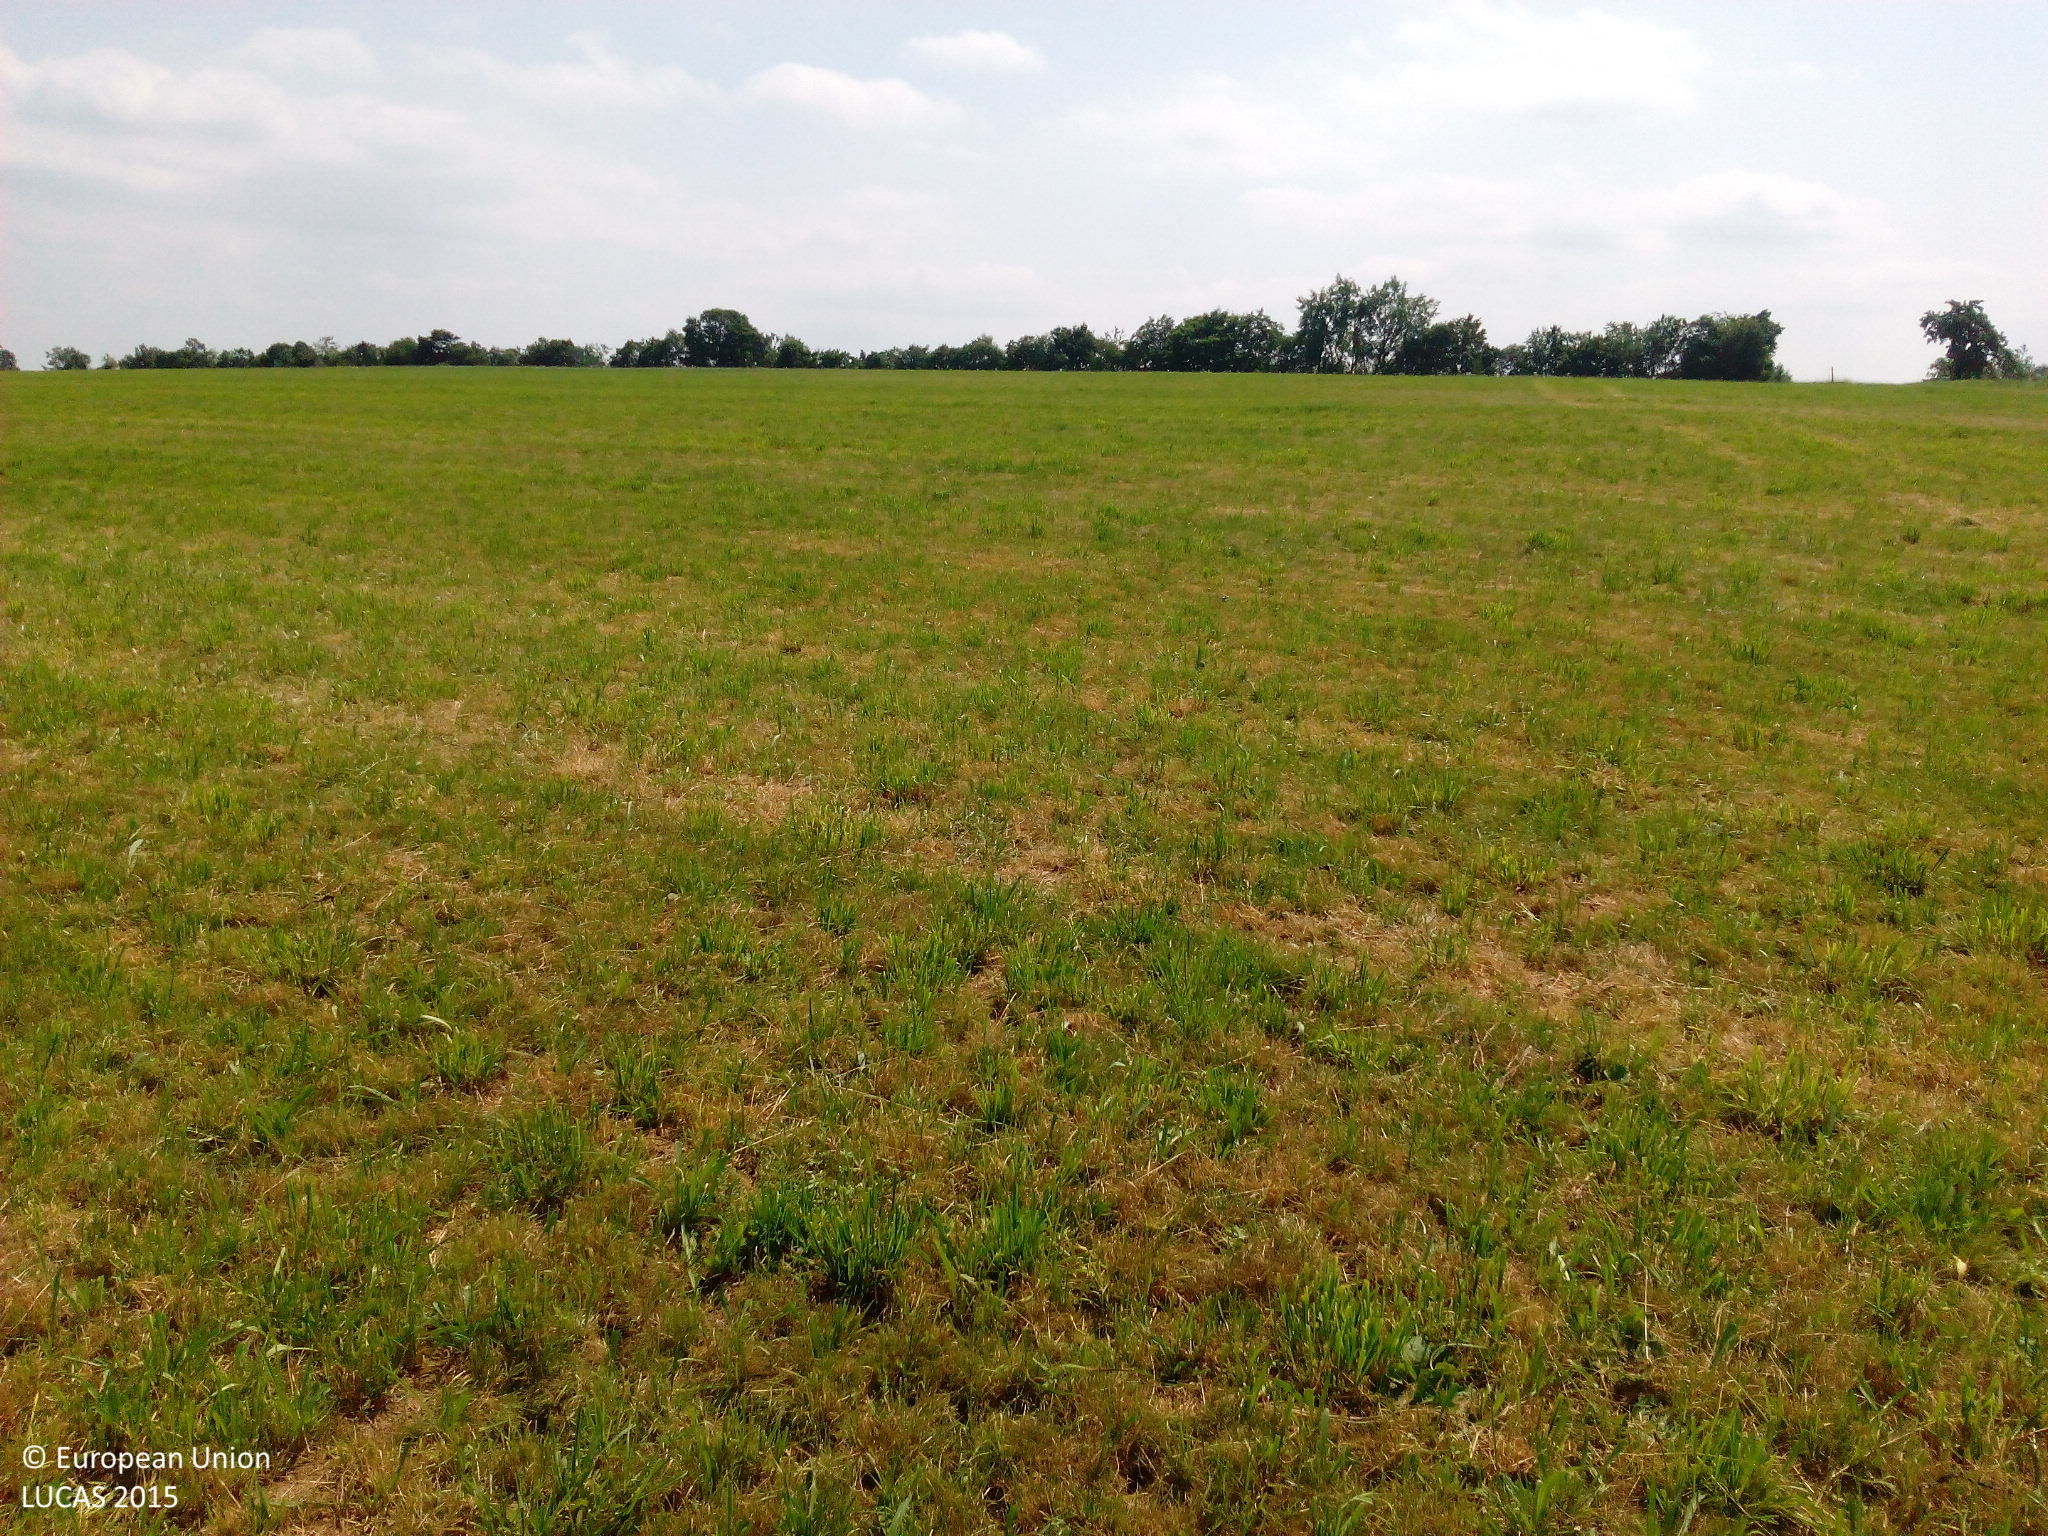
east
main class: Grassland
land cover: Grassland without tree/shrub cover
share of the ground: > 75 %
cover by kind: herbaceous plants 100 %
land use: Agriculture (excluding fallow land and kitchen gardens)
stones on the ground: < 10 %
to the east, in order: Grassland without tree/shrub cover
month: July
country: DE
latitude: 48.4029
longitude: 9.6355
